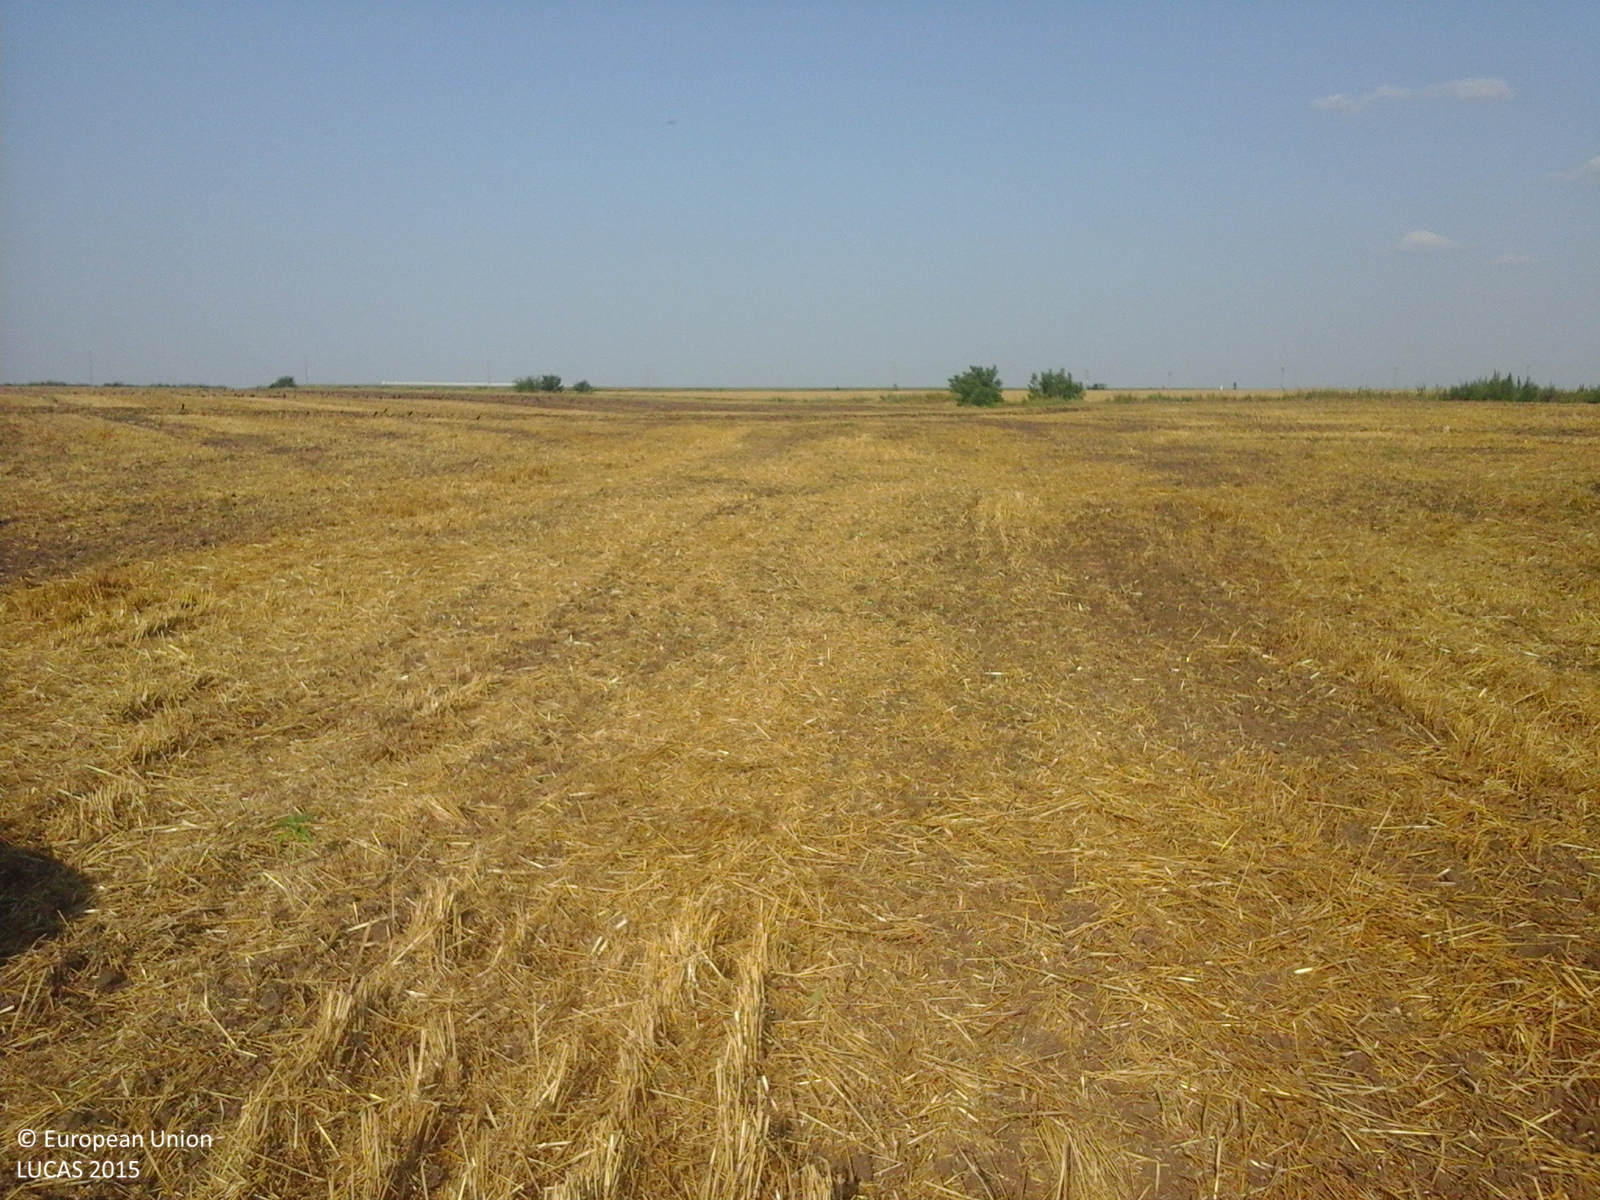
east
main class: Cropland
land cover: Common wheat
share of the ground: > 75 %
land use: Agriculture (excluding fallow land and kitchen gardens)
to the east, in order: Common wheat; Grass margins; Ditches and canals; Grass margins; Common wheat
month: July
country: RO
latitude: 44.9135
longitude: 26.6021
